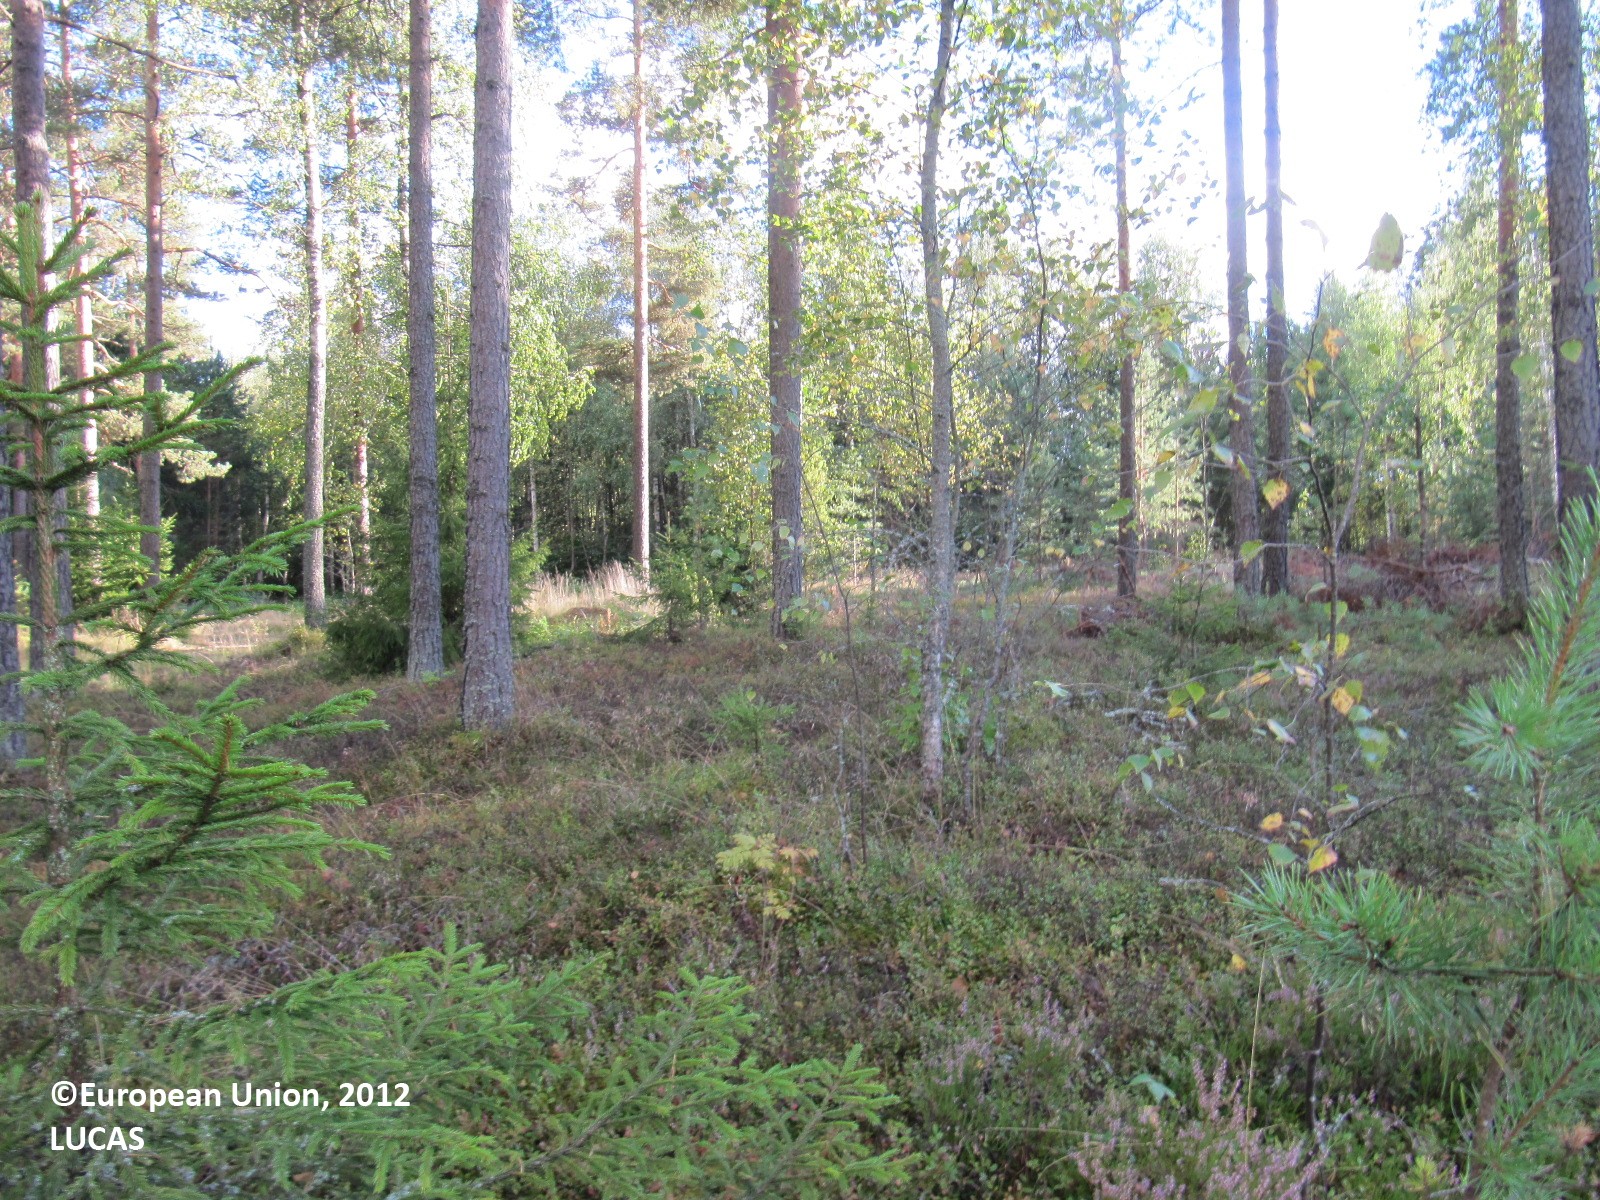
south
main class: Woodland
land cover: Pine dominated mixed woodland
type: boreal forest
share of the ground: 25 - 50 %
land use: Forestry
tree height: > 5 m
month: September
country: FI
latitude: 60.0899
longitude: 23.7399
